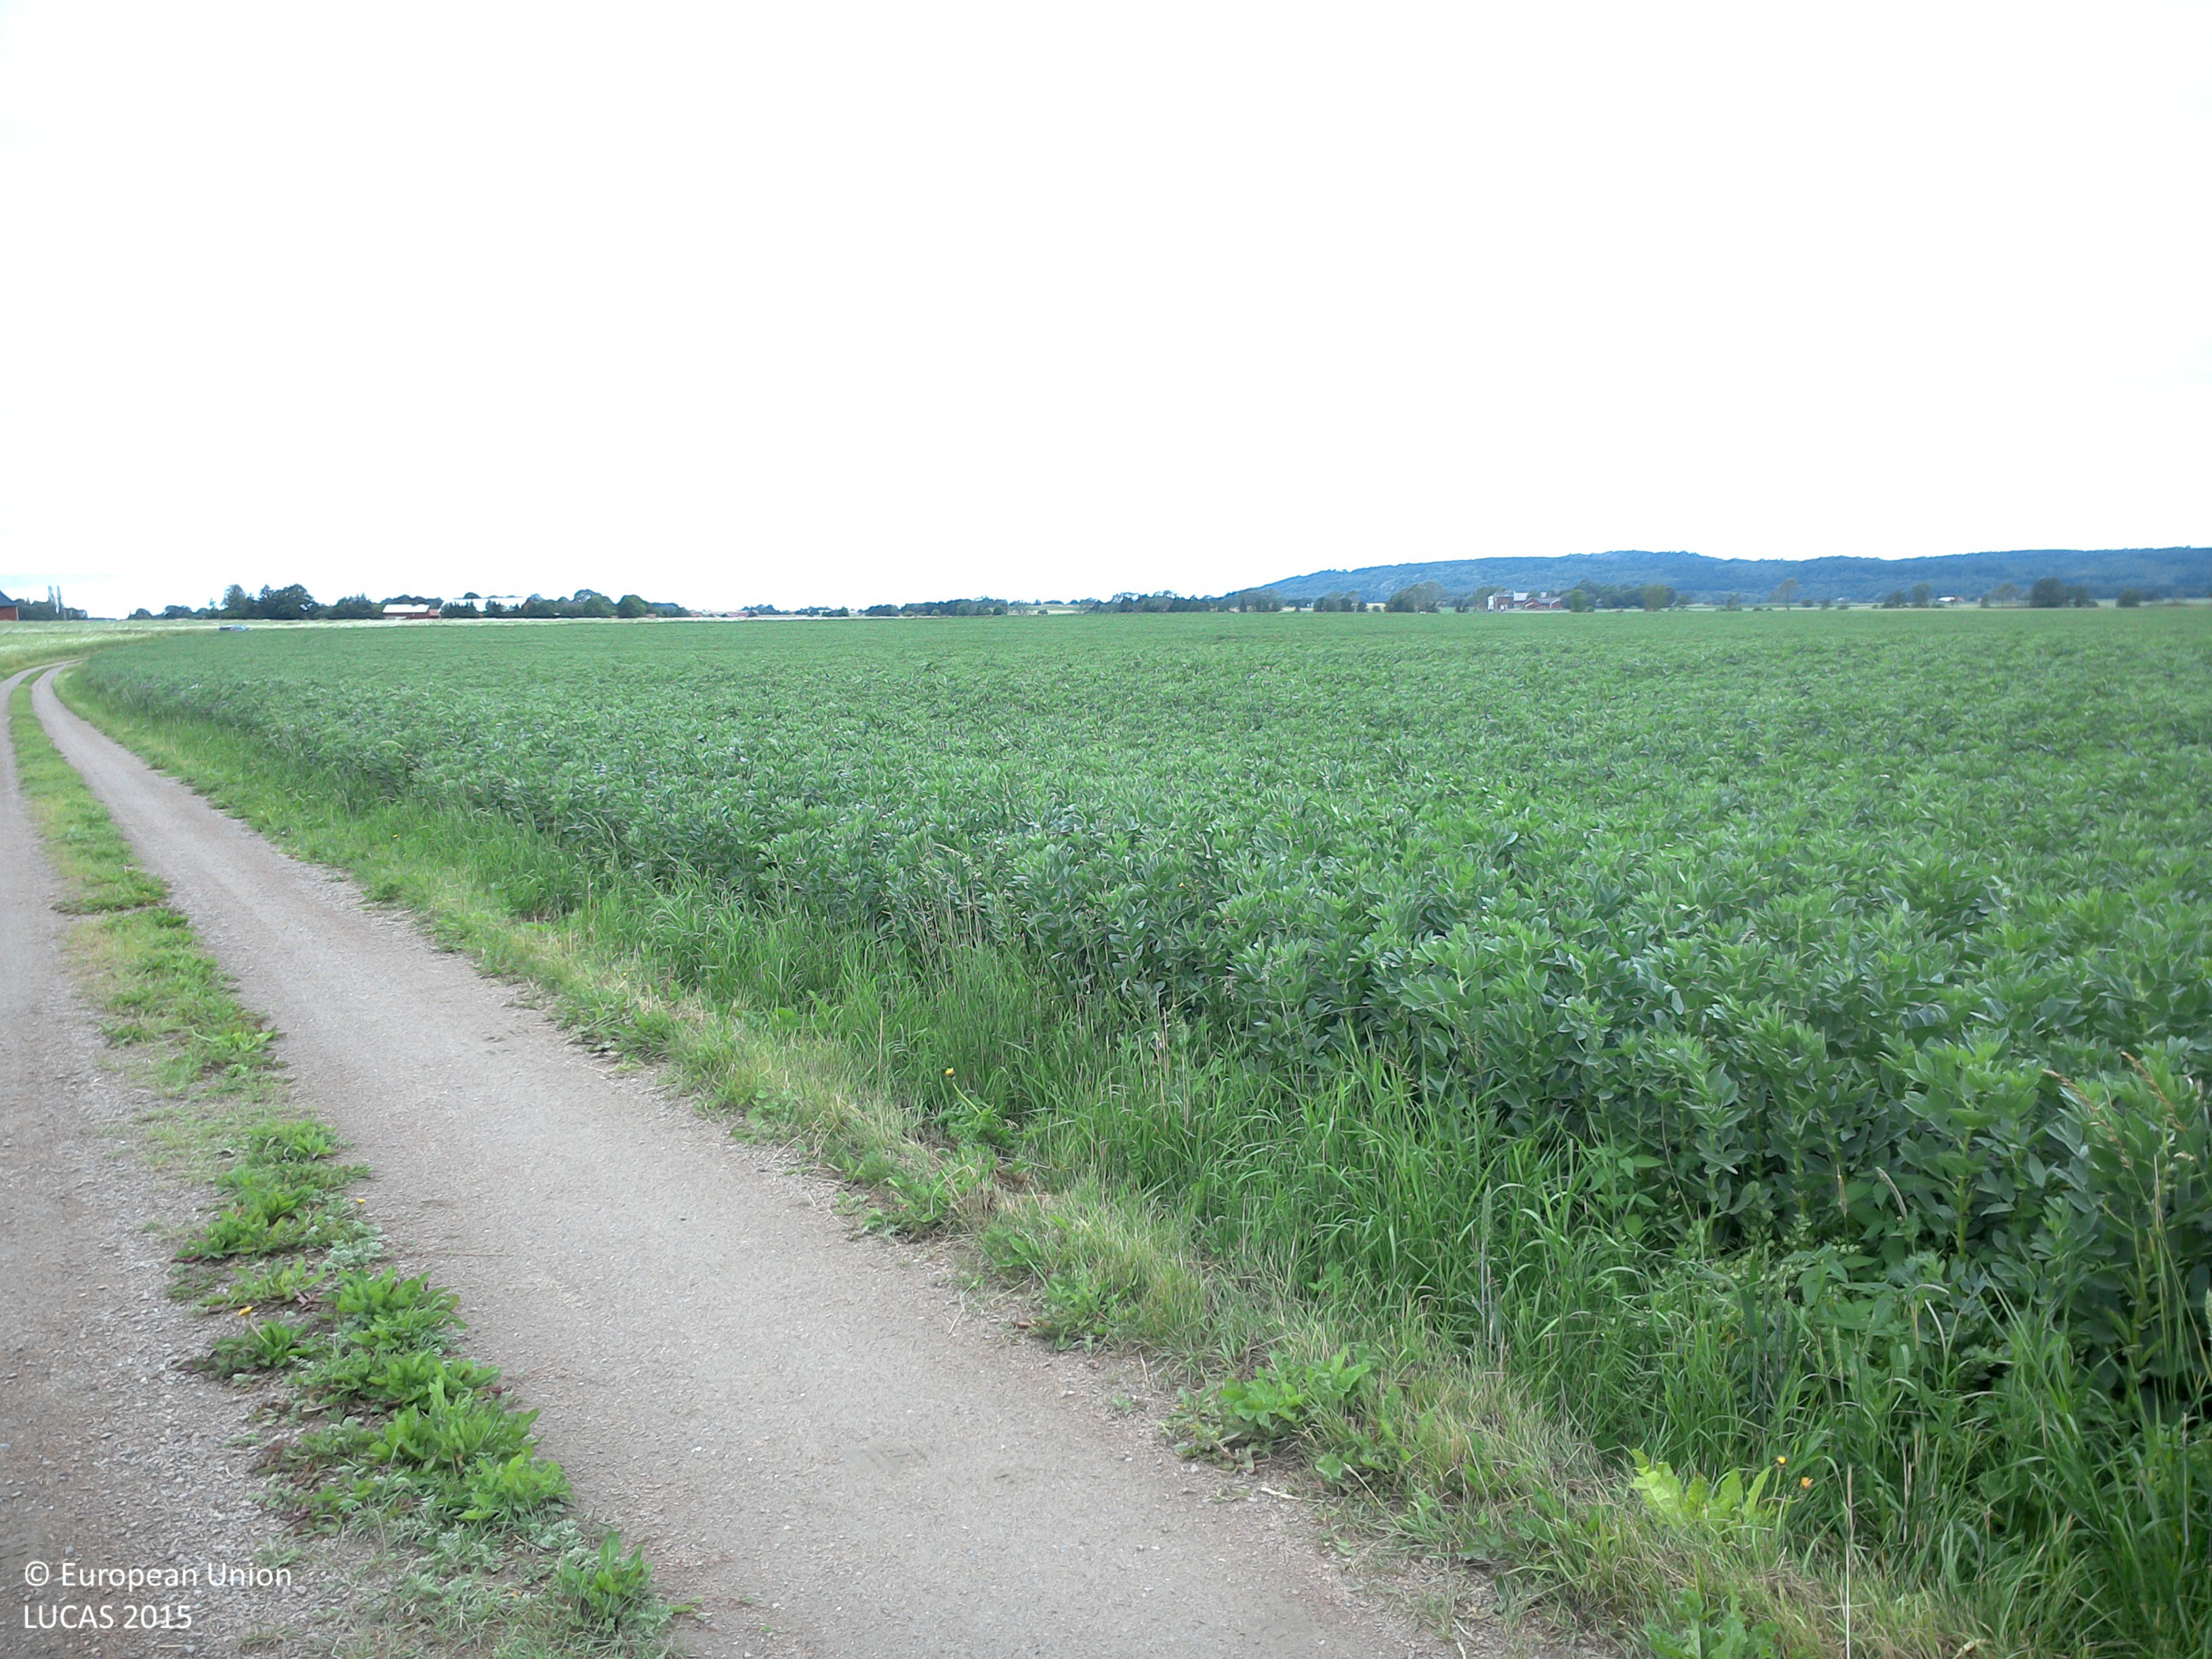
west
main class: Cropland
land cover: Dry pulses
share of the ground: > 75 %
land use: Agriculture (excluding fallow land and kitchen gardens)
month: July
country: SE
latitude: 58.2977
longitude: 14.7541
